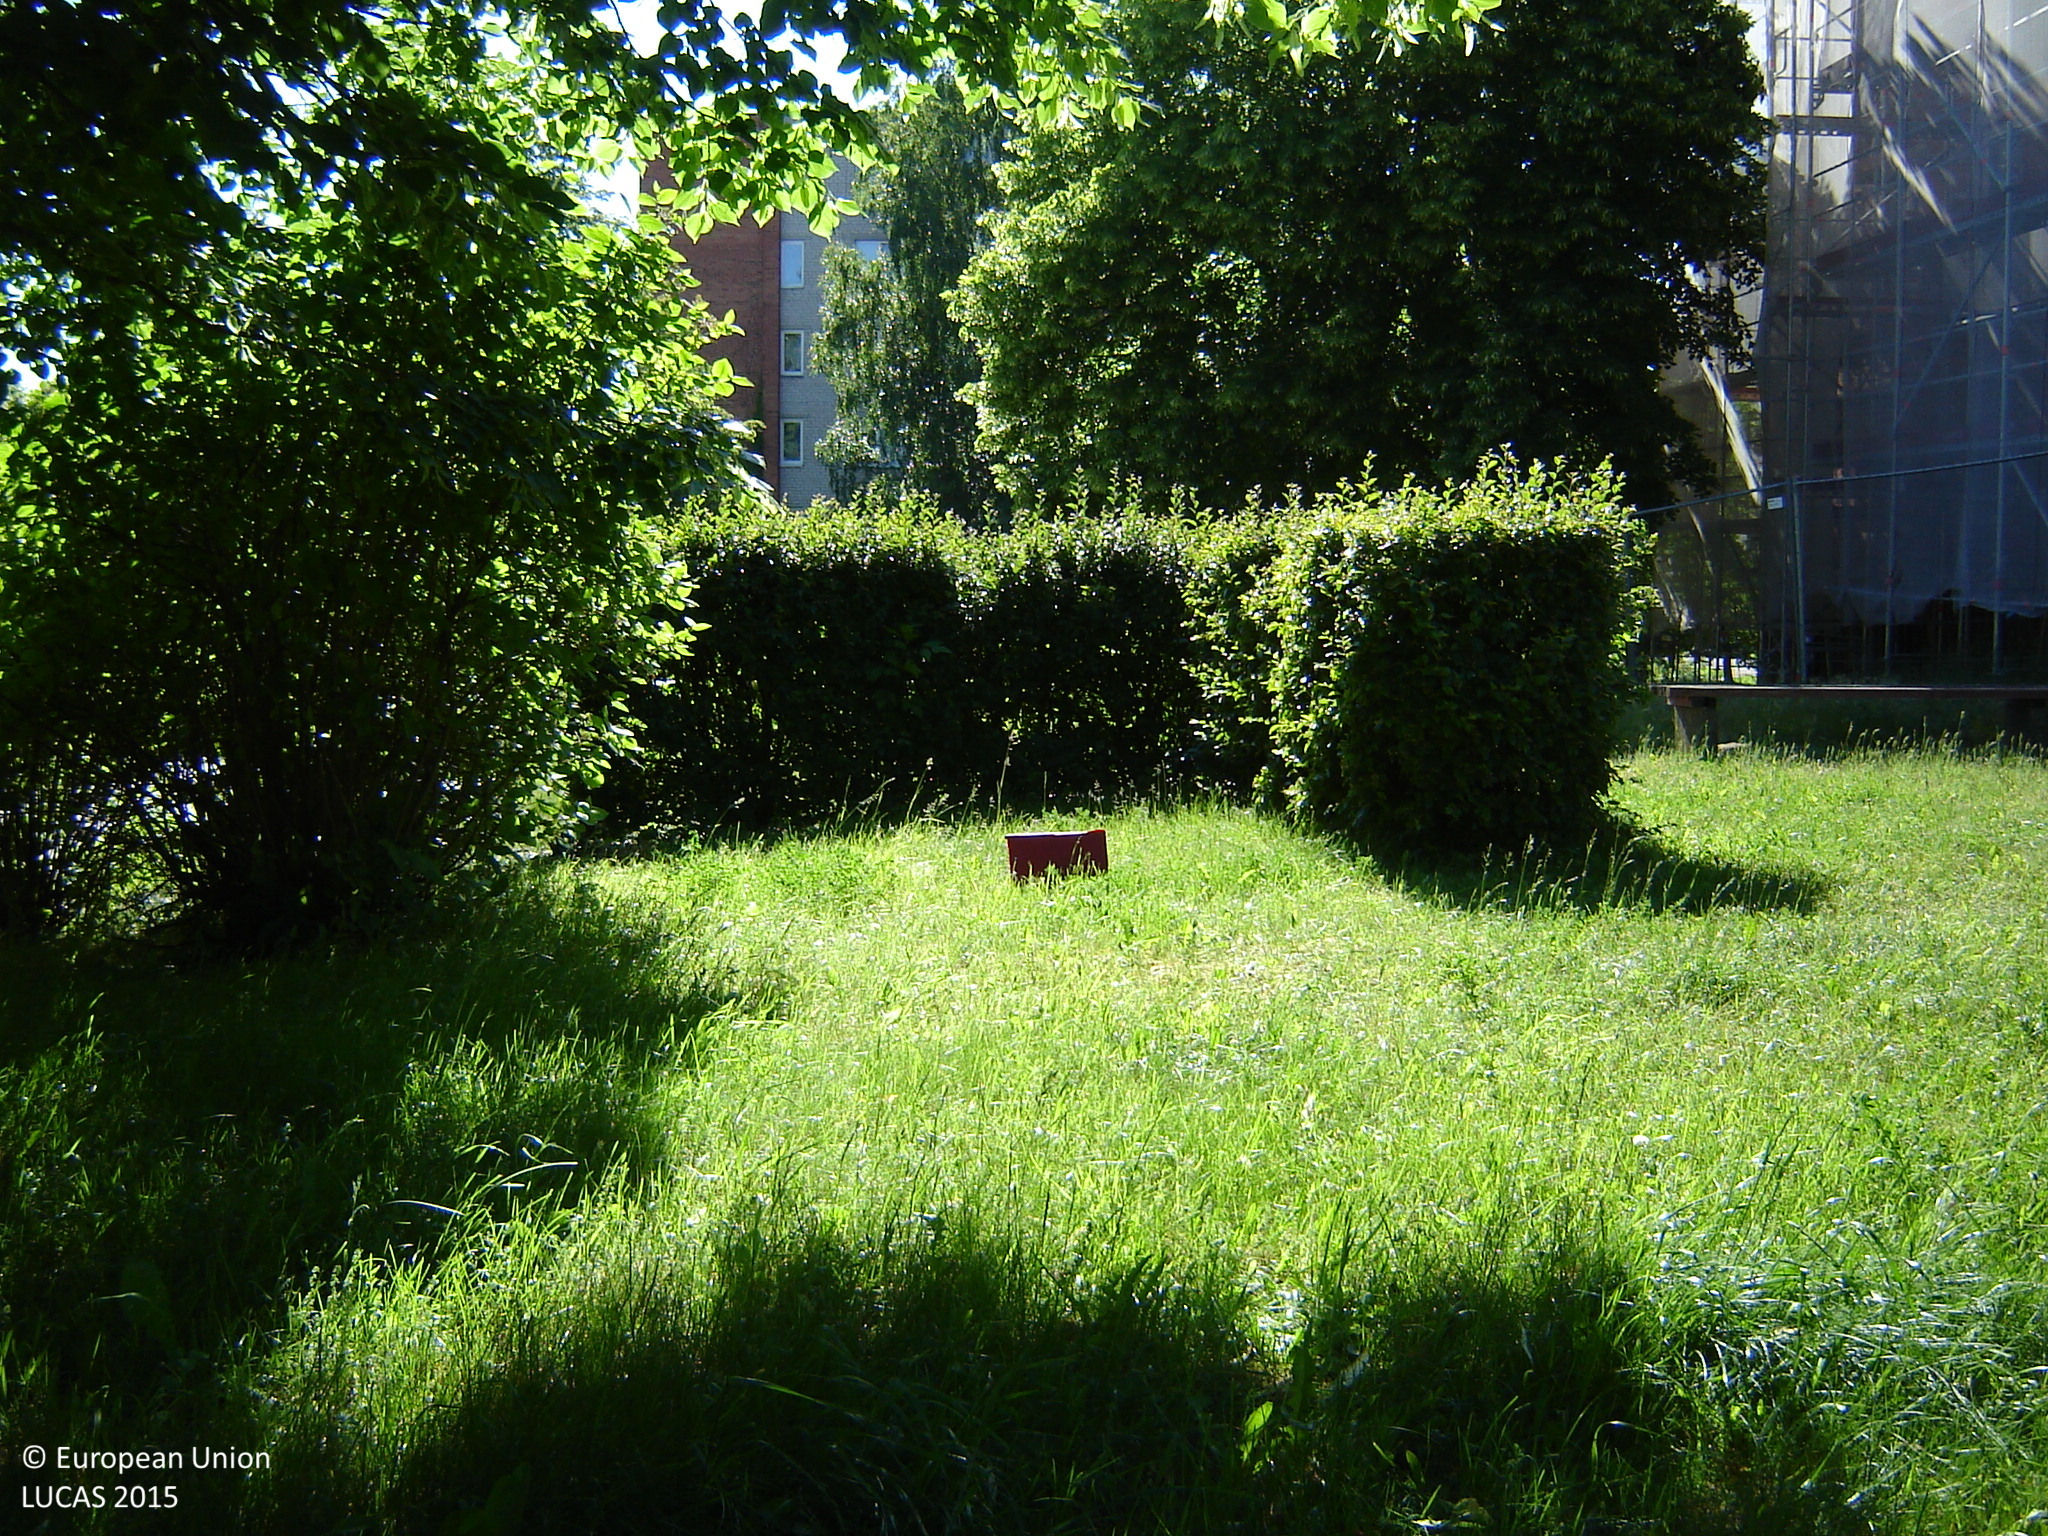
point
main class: Grassland
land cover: Grassland without tree/shrub cover
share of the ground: > 75 %
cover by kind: herbaceous plants 100 %
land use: Residential
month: June
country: LT
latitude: 55.5231
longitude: 25.1150
